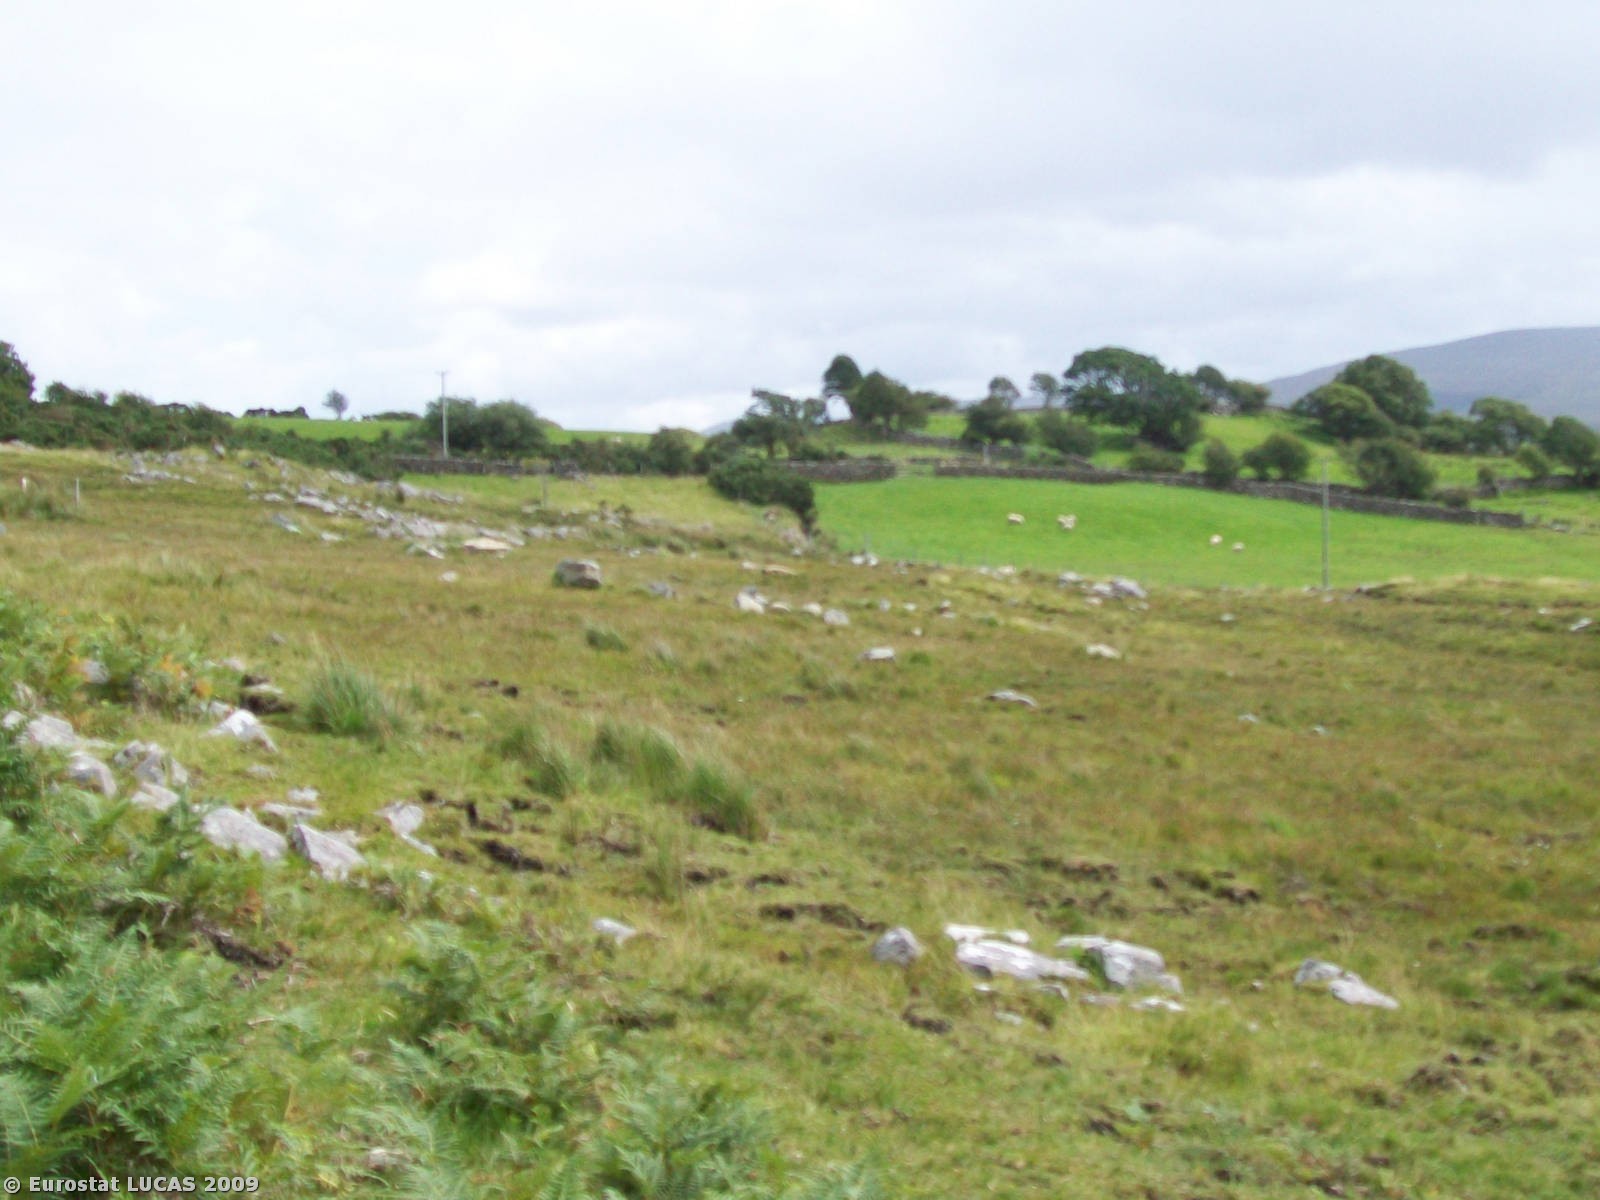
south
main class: Grassland
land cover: Grassland without tree/shrub cover
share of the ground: > 75 %
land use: Agriculture (excluding fallow land and kitchen gardens)
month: July
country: IE
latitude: 53.6955
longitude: -9.5443
